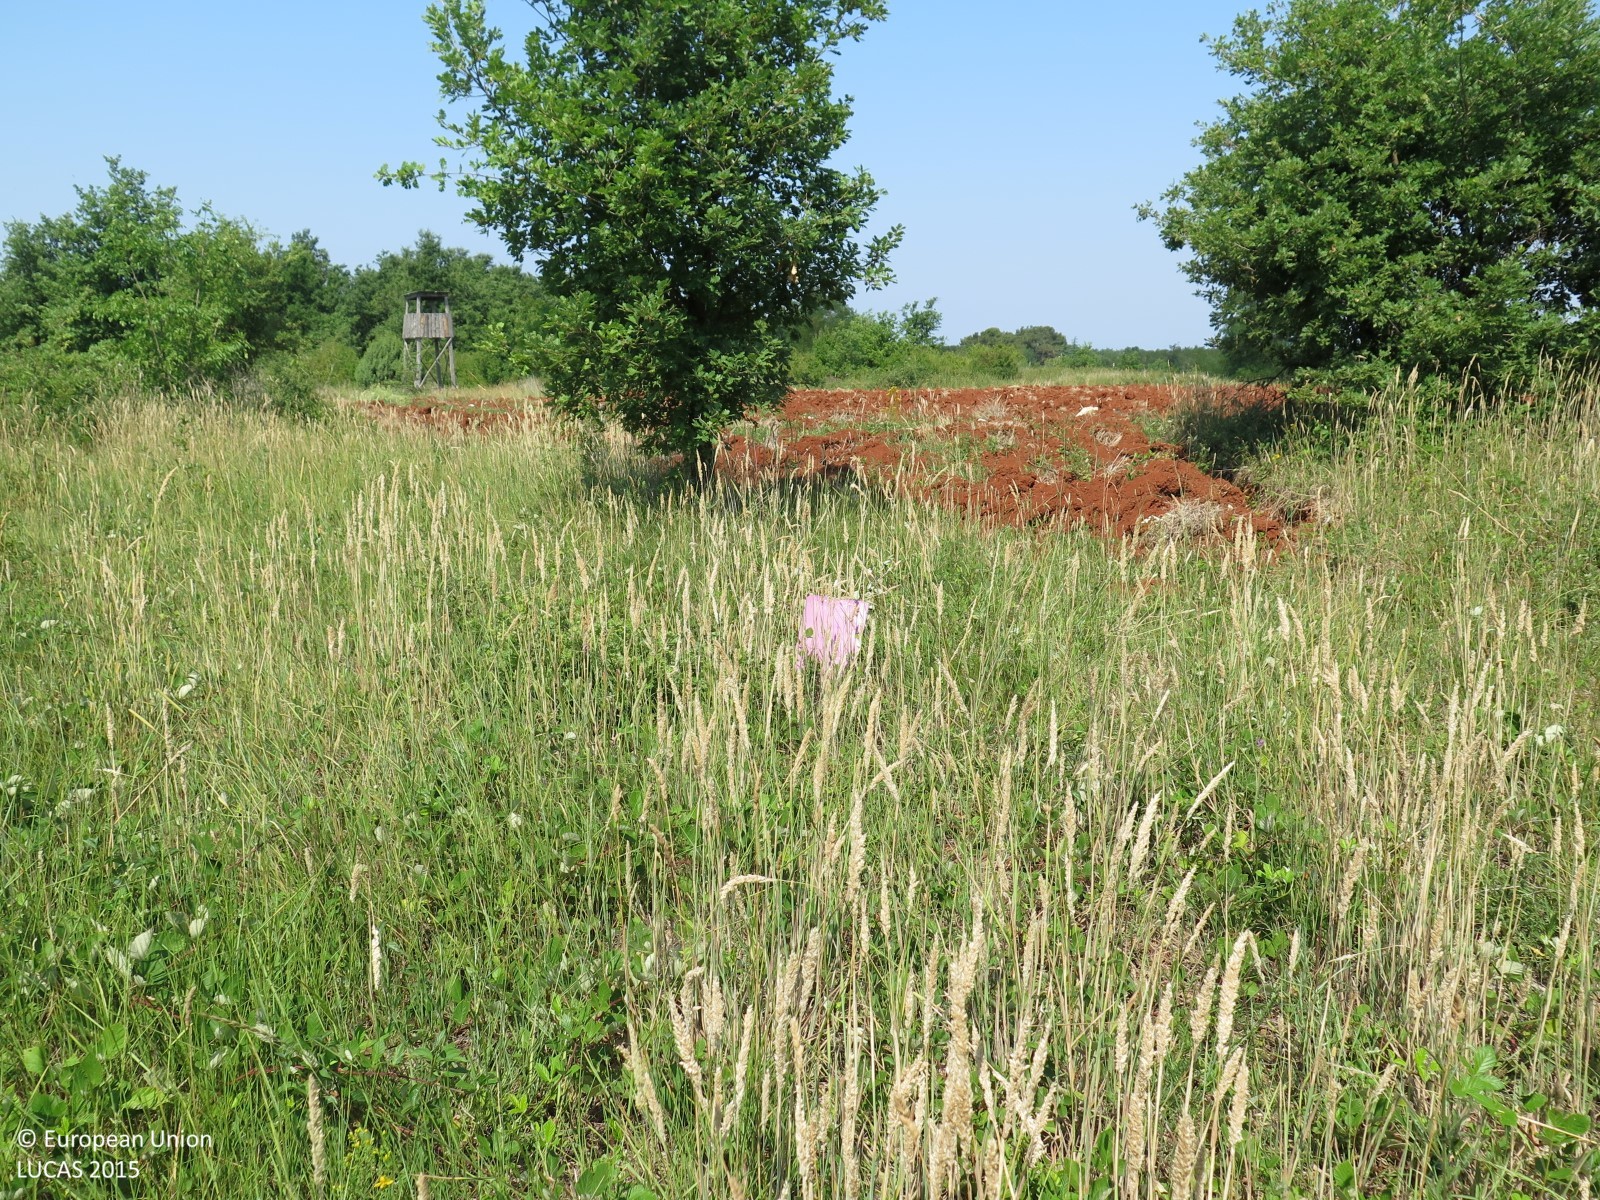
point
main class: Grassland
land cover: Grassland with sparse tree/shrub cover
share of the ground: > 75 %
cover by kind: herbaceous plants 90 %, broadleaved forest trees 5 %, shrubs 5 %
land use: Semi-natural and natural areas not in use
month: July
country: HR
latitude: 45.2788
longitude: 13.6536
